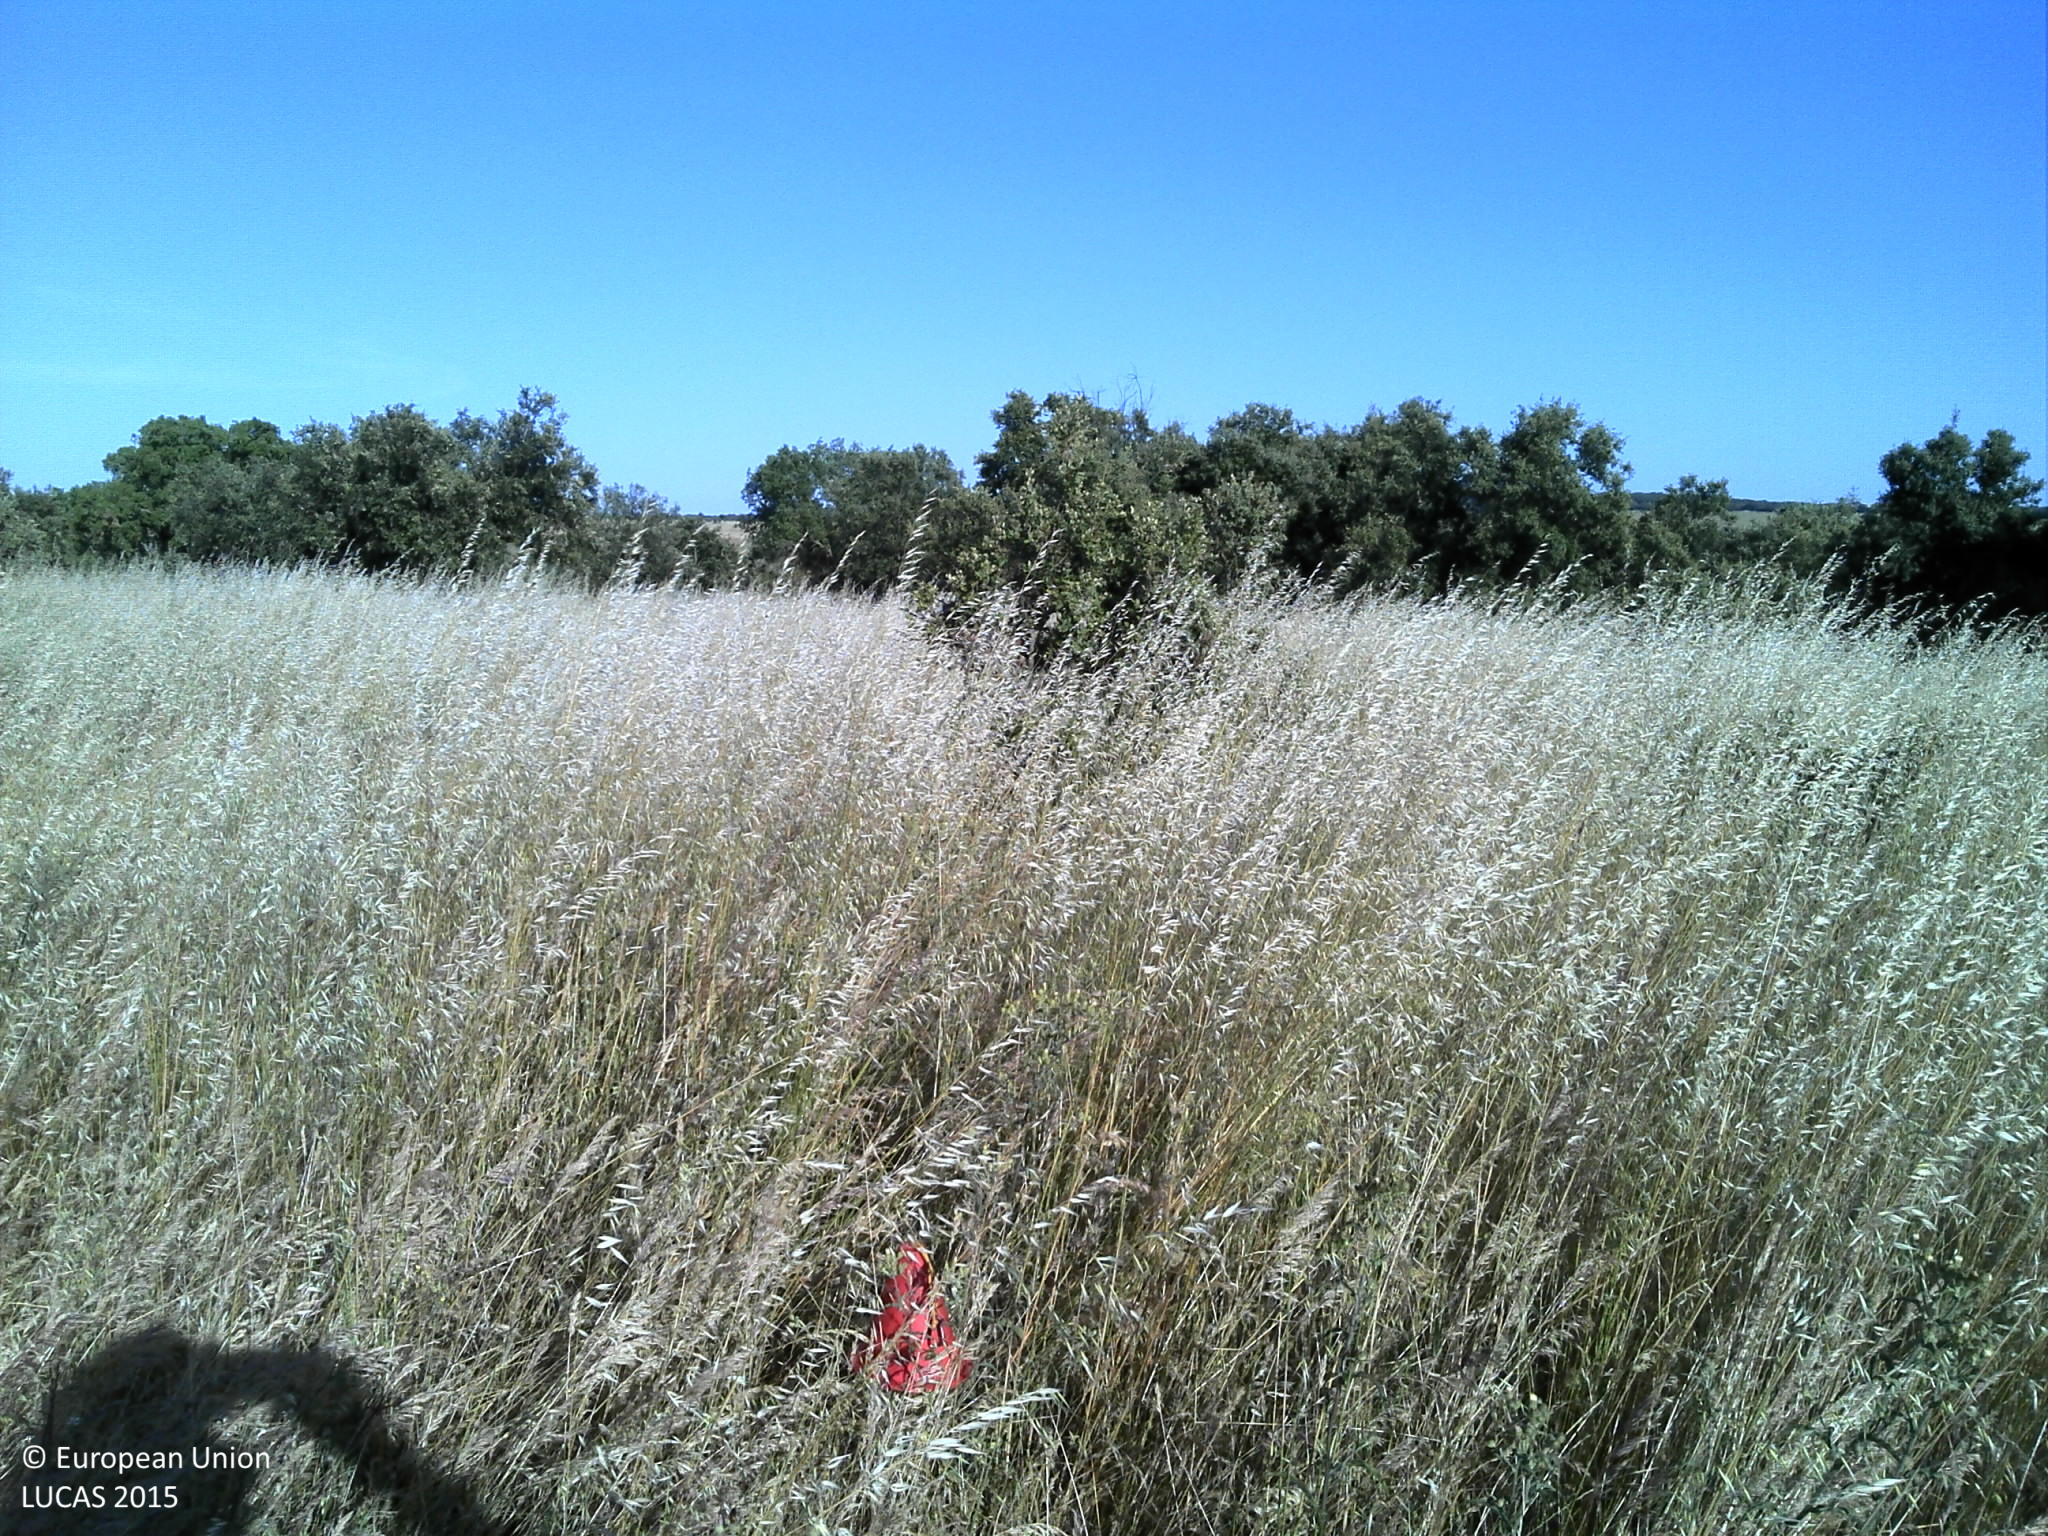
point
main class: Grassland
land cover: Grassland with sparse tree/shrub cover
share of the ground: > 75 %
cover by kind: herbaceous plants 90 %, broadleaved forest trees 5 %, unconsolidated bare surface 5 %
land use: Agriculture (excluding fallow land and kitchen gardens)
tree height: < 5 m
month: May
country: PT
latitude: 39.2312
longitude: -7.6185
